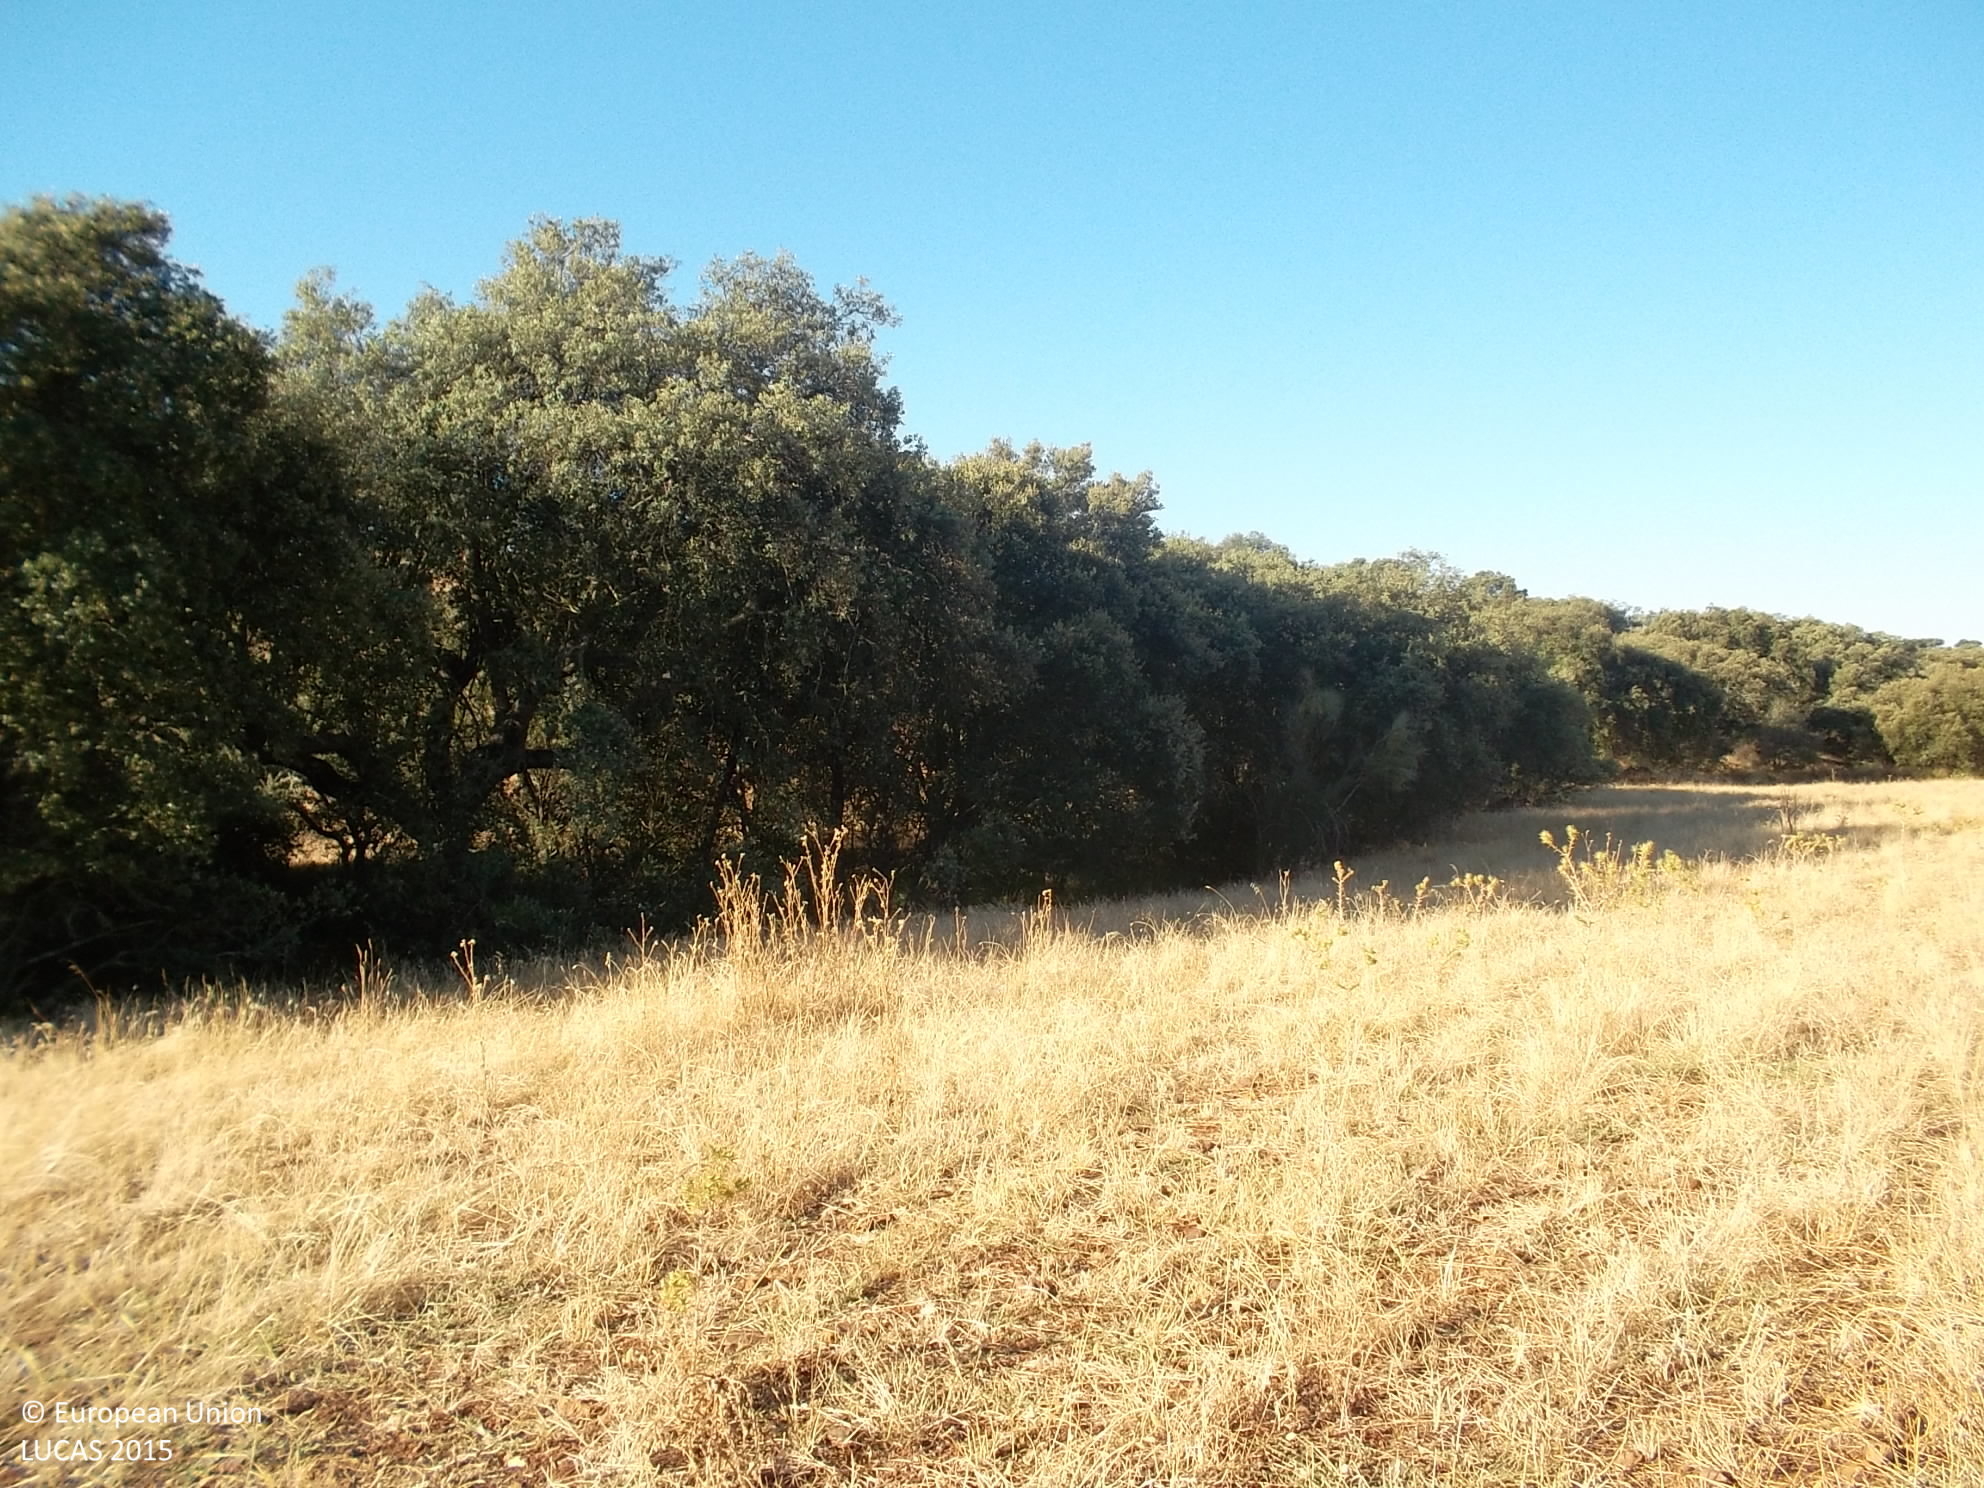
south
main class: Grassland
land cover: Grassland with sparse tree/shrub cover
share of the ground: > 75 %
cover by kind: herbaceous plants 95 %, broadleaved forest trees 5 %
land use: Agriculture (excluding fallow land and kitchen gardens)
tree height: < 5 m
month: July
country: ES
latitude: 38.4918
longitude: -5.7349
